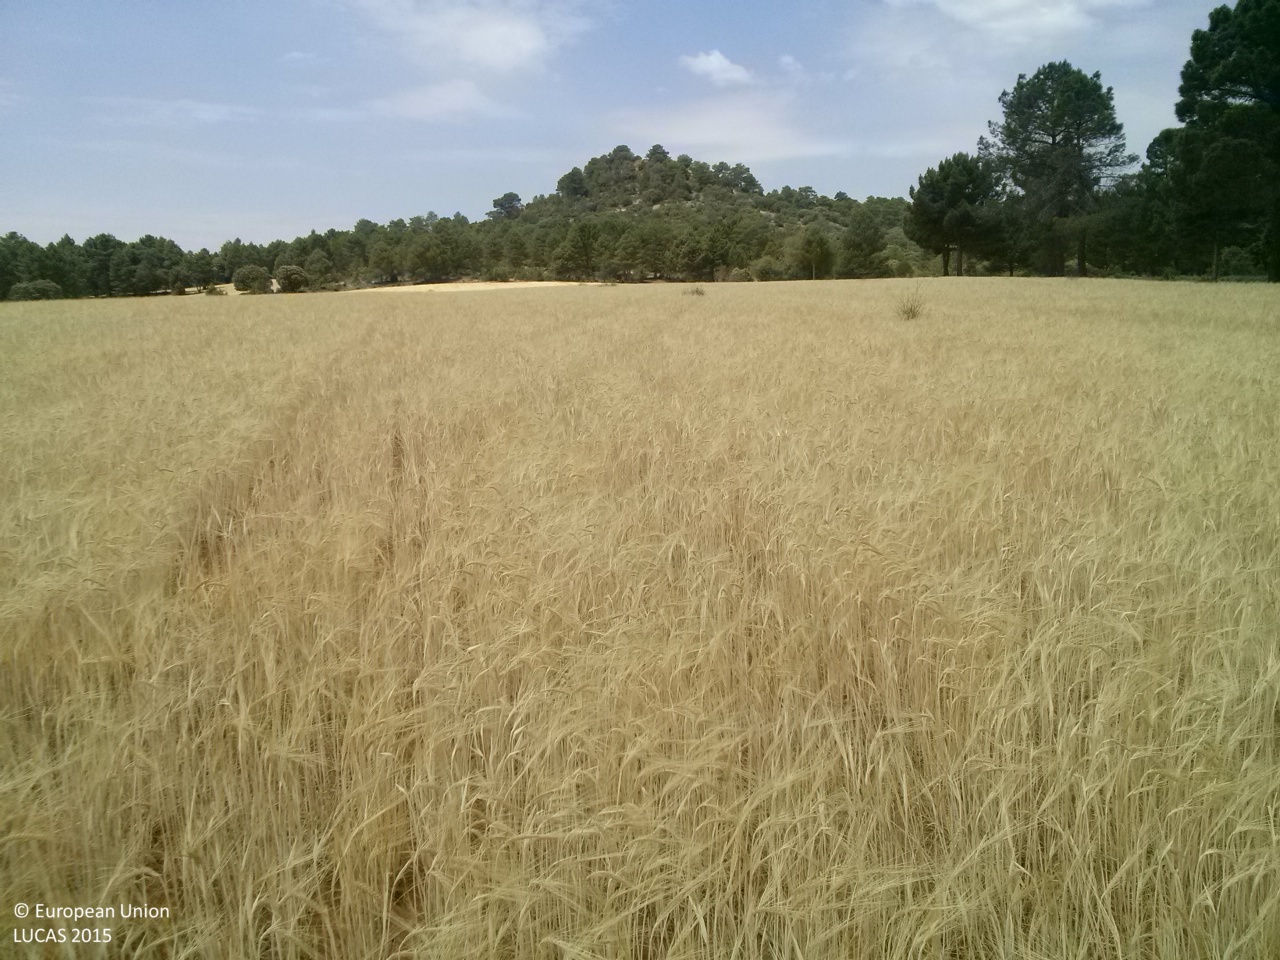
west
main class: Cropland
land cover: Barley
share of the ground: > 75 %
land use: Agriculture (excluding fallow land and kitchen gardens)
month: June
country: ES
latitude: 39.9724
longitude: -1.8023
